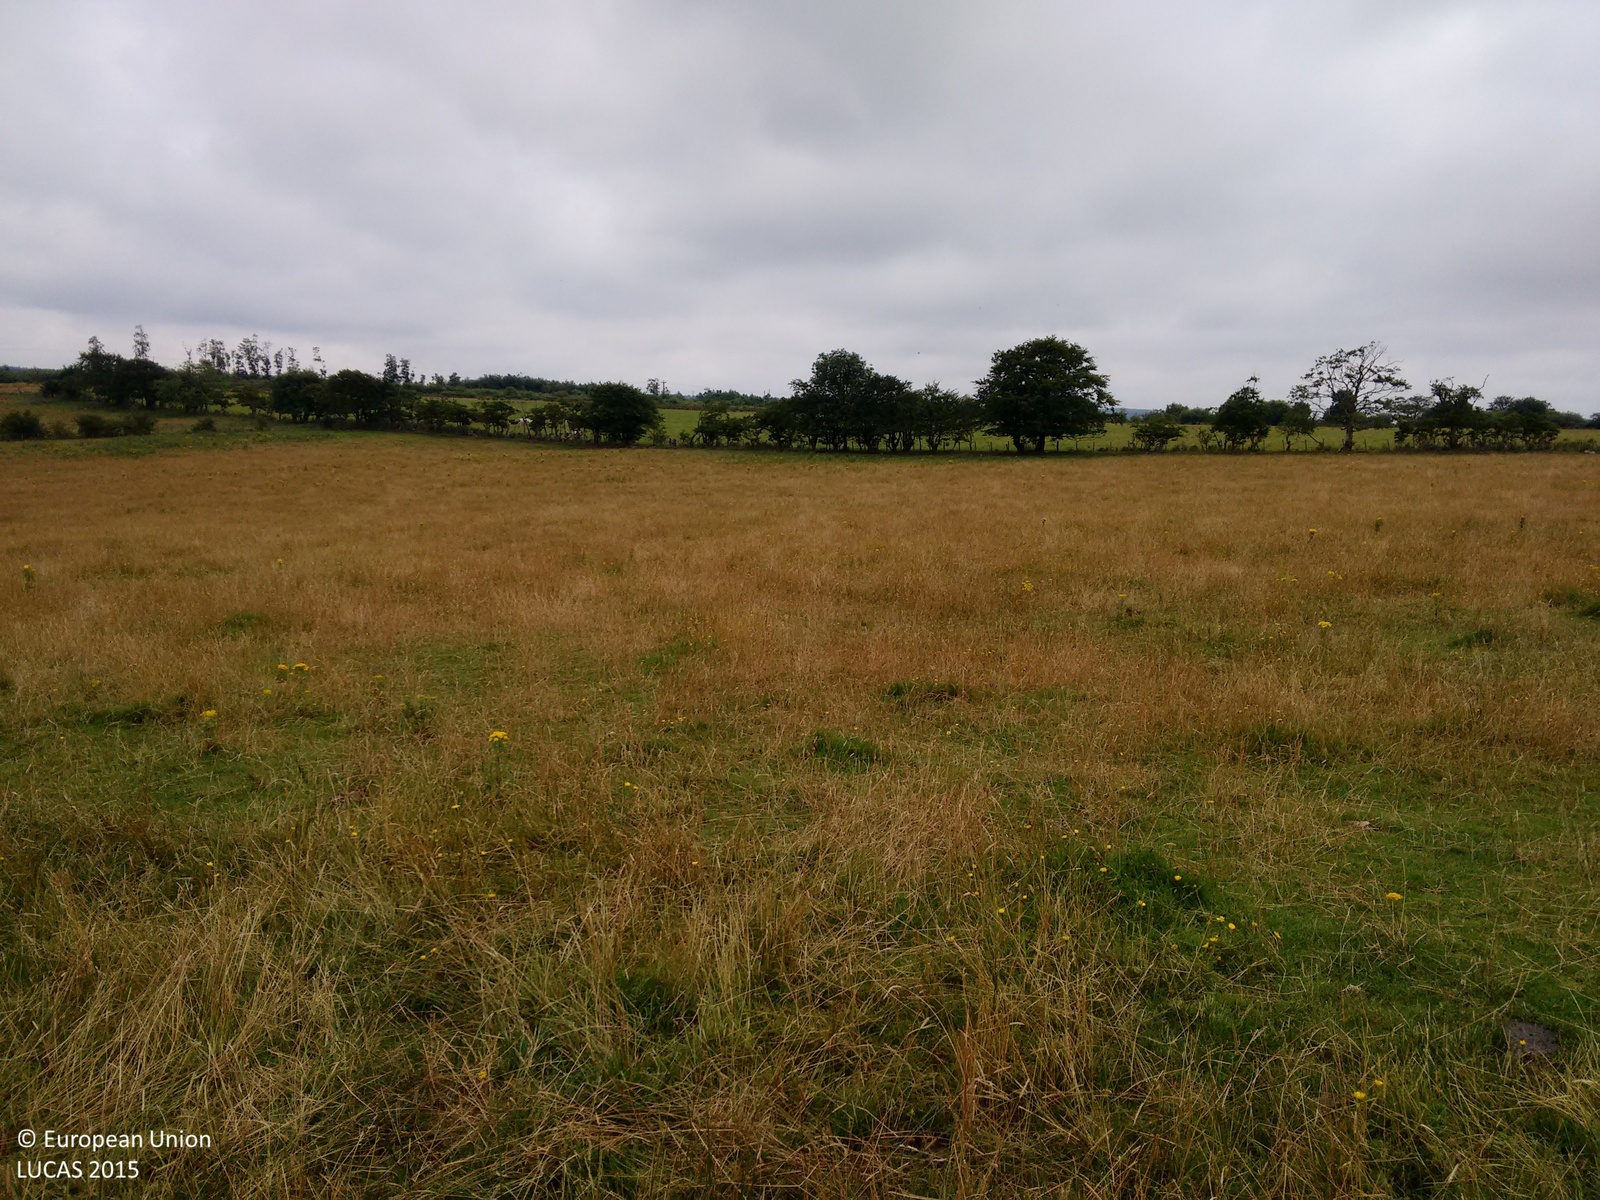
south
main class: Grassland
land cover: Grassland without tree/shrub cover
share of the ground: > 75 %
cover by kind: herbaceous plants 100 %
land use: Agriculture (excluding fallow land and kitchen gardens)
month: August
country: GB
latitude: 55.4318
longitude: -4.3355
